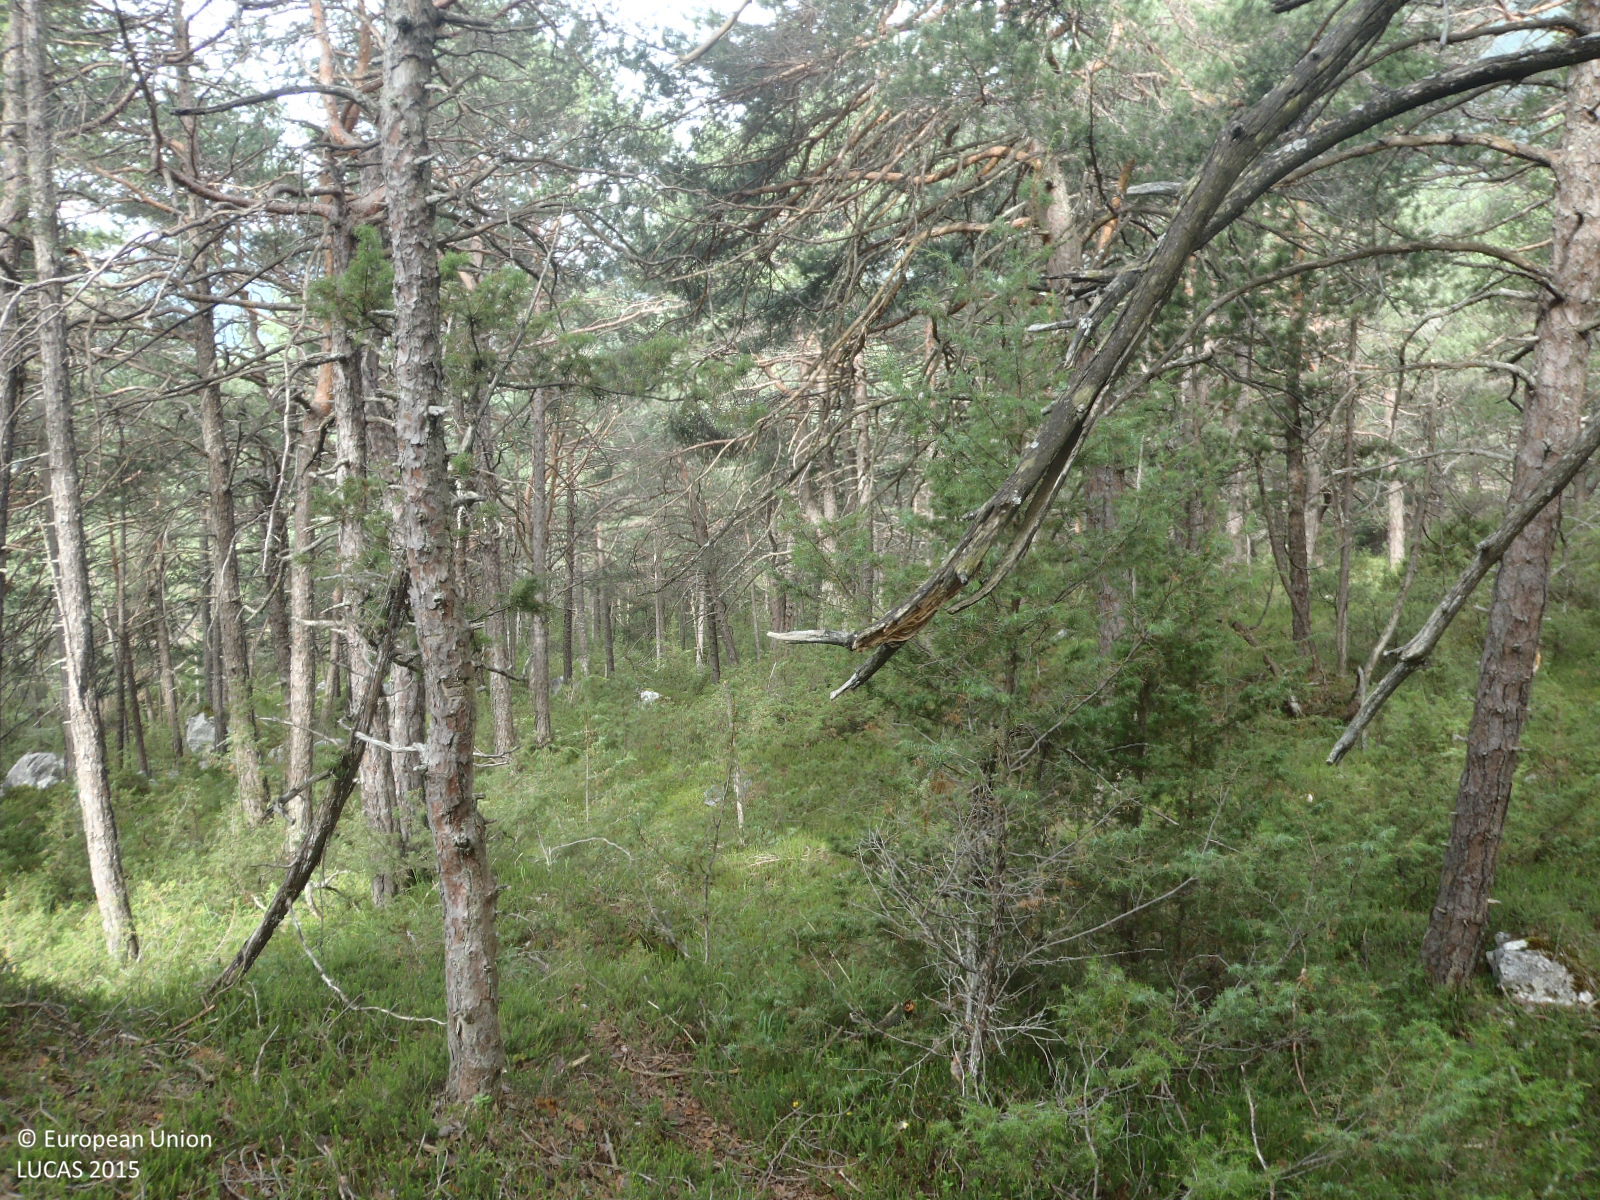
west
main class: Woodland
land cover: Pine dominated coniferous woodland
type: alpine coniferous forest
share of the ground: > 75 %
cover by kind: coniferous forest trees 80 %, shrubs 15 %, consolidated bare surface 5 %
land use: Semi-natural and natural areas not in use
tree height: > 5 m
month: July
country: AT
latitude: 47.3193
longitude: 10.9649
